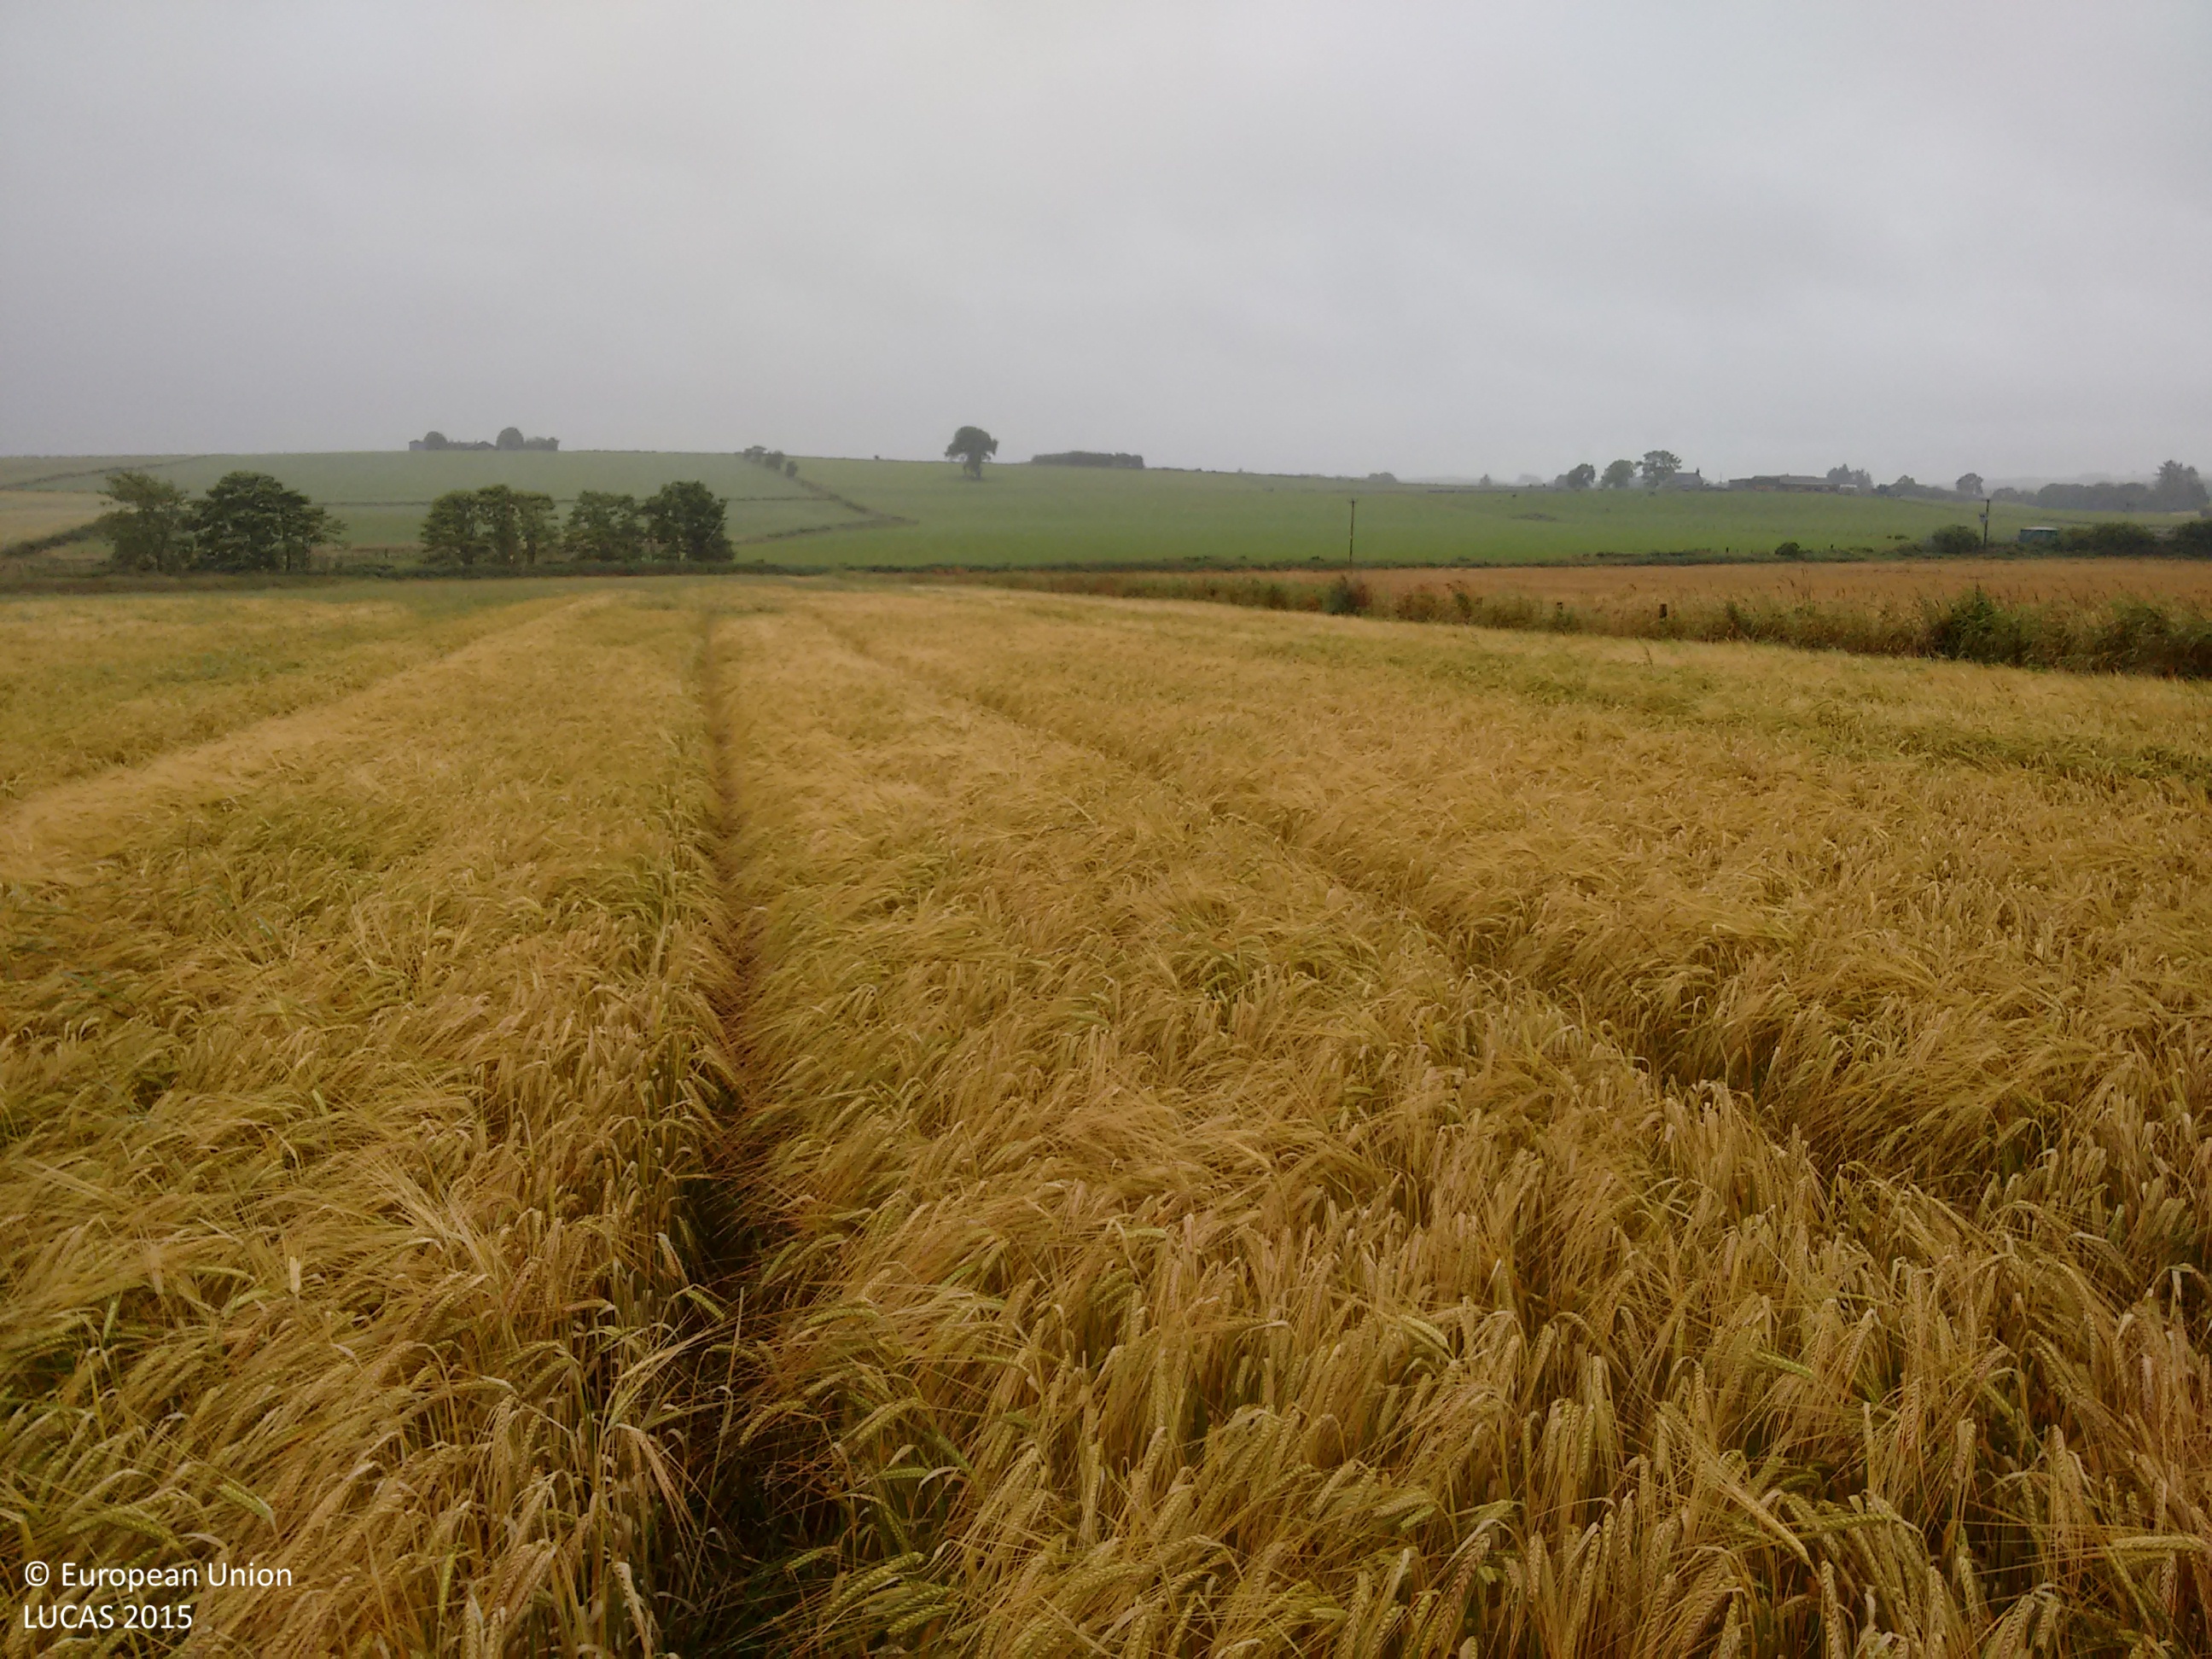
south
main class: Cropland
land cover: Barley
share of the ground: > 75 %
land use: Agriculture (excluding fallow land and kitchen gardens)
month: August
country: GB
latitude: 57.3047
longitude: -2.1149
